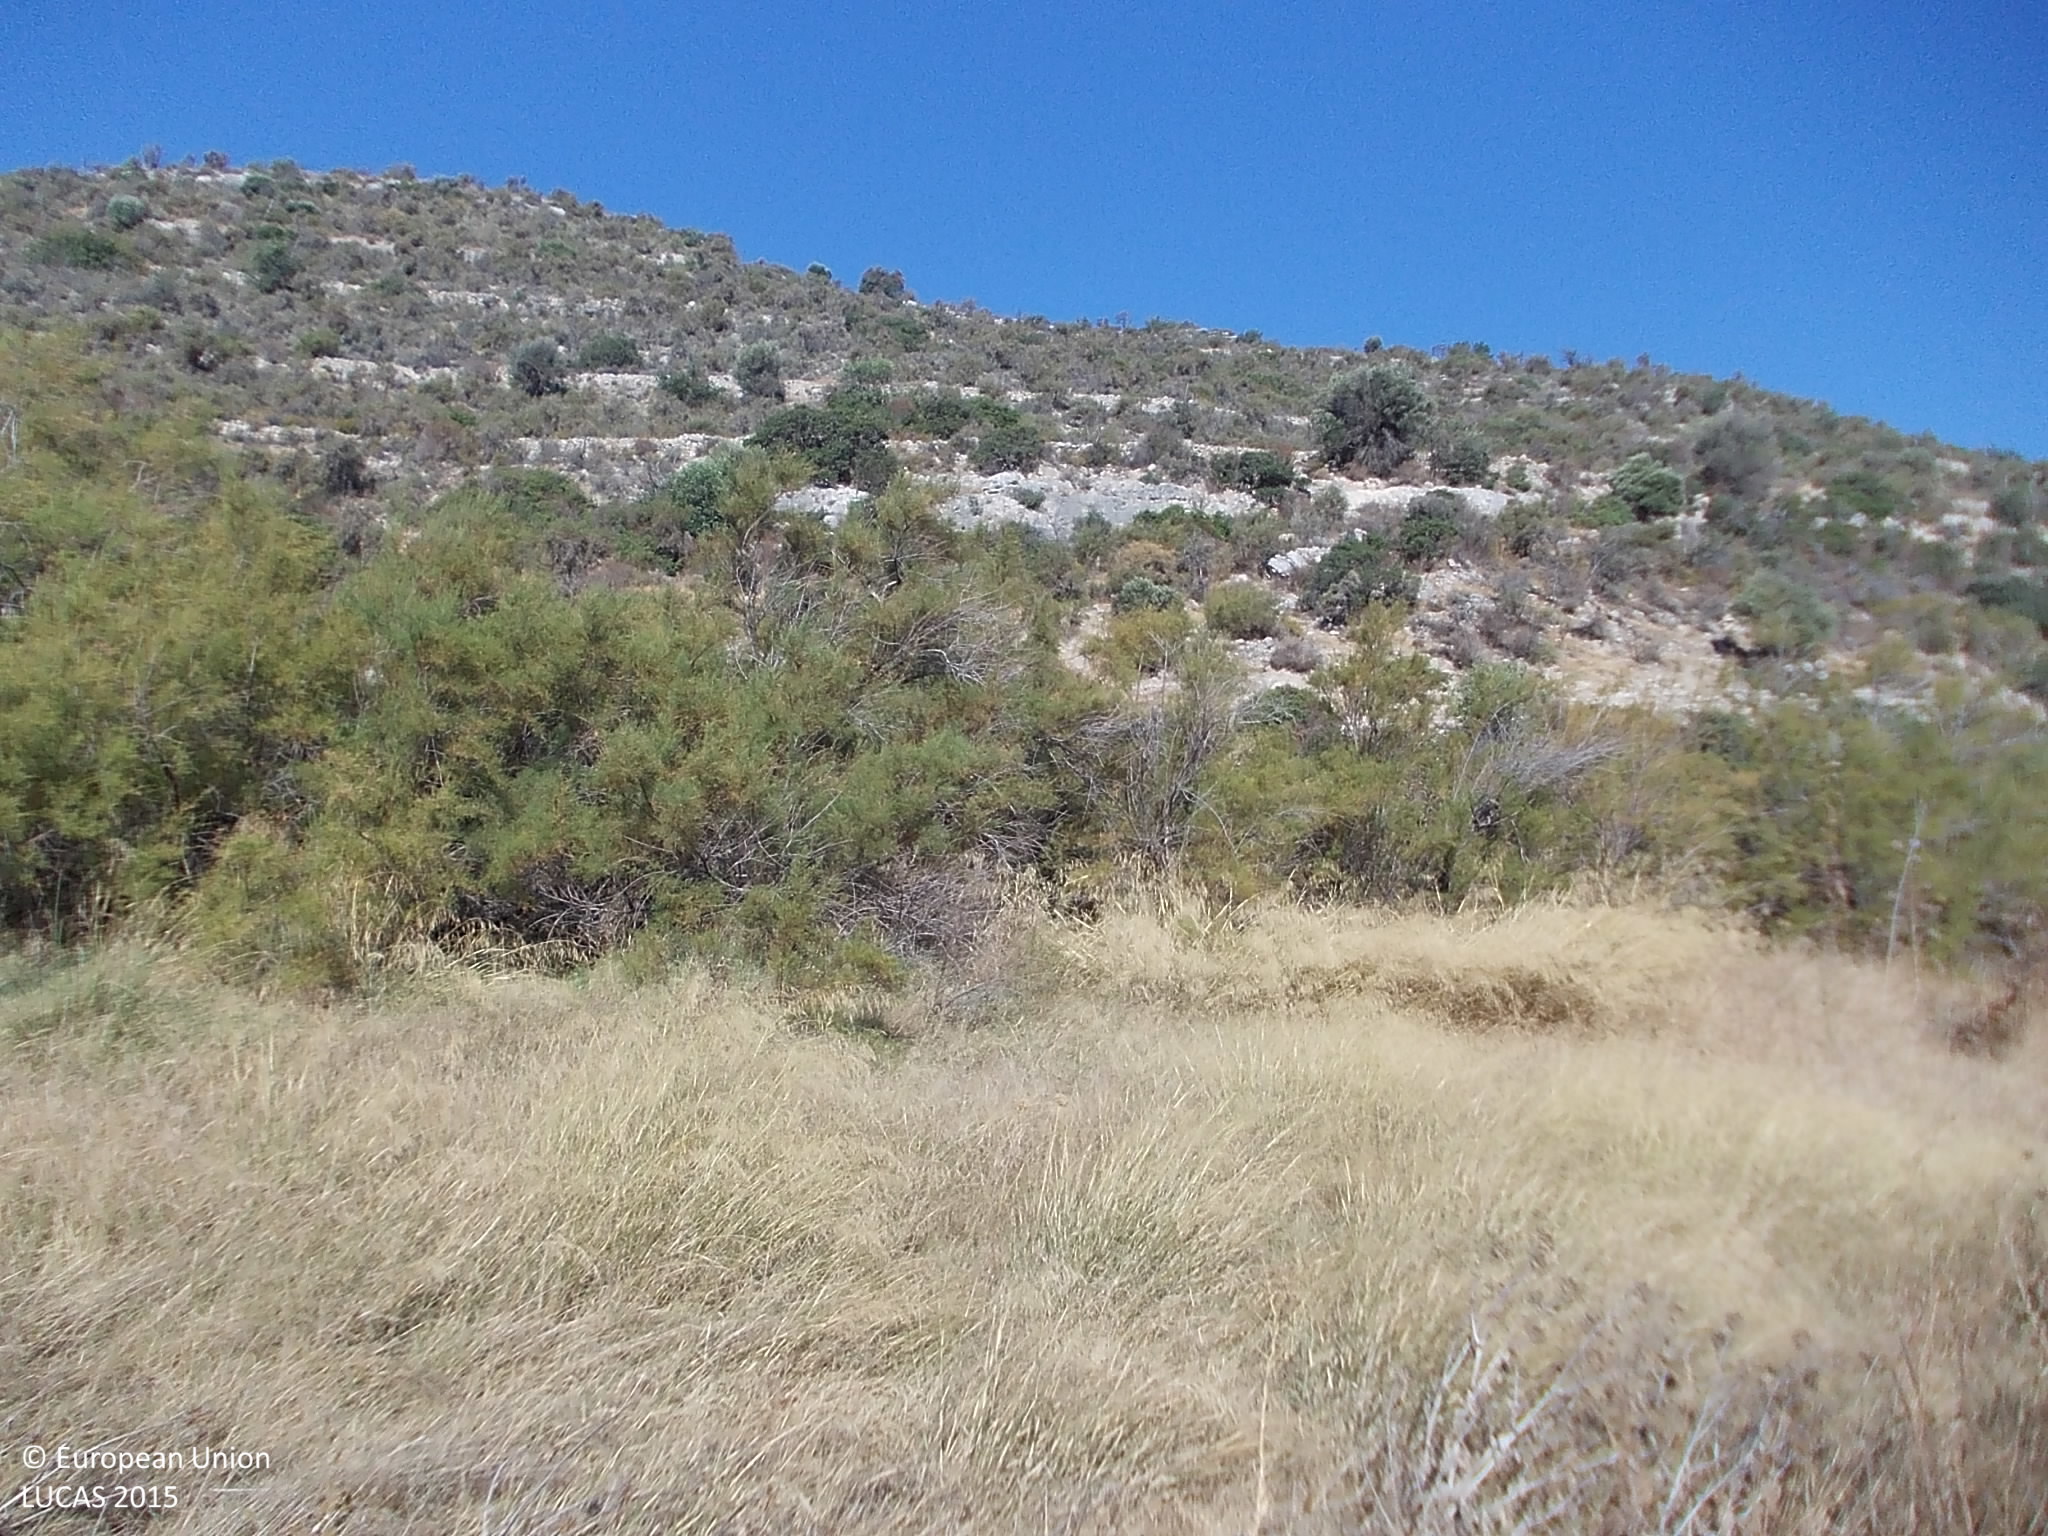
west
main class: Shrubland
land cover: Shrubland without tree cover
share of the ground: > 75 %
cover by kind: shrubs 85 %, herbaceous plants 10 %
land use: Semi-natural and natural areas not in use
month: August
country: CY
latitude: 34.7250
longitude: 32.9763
